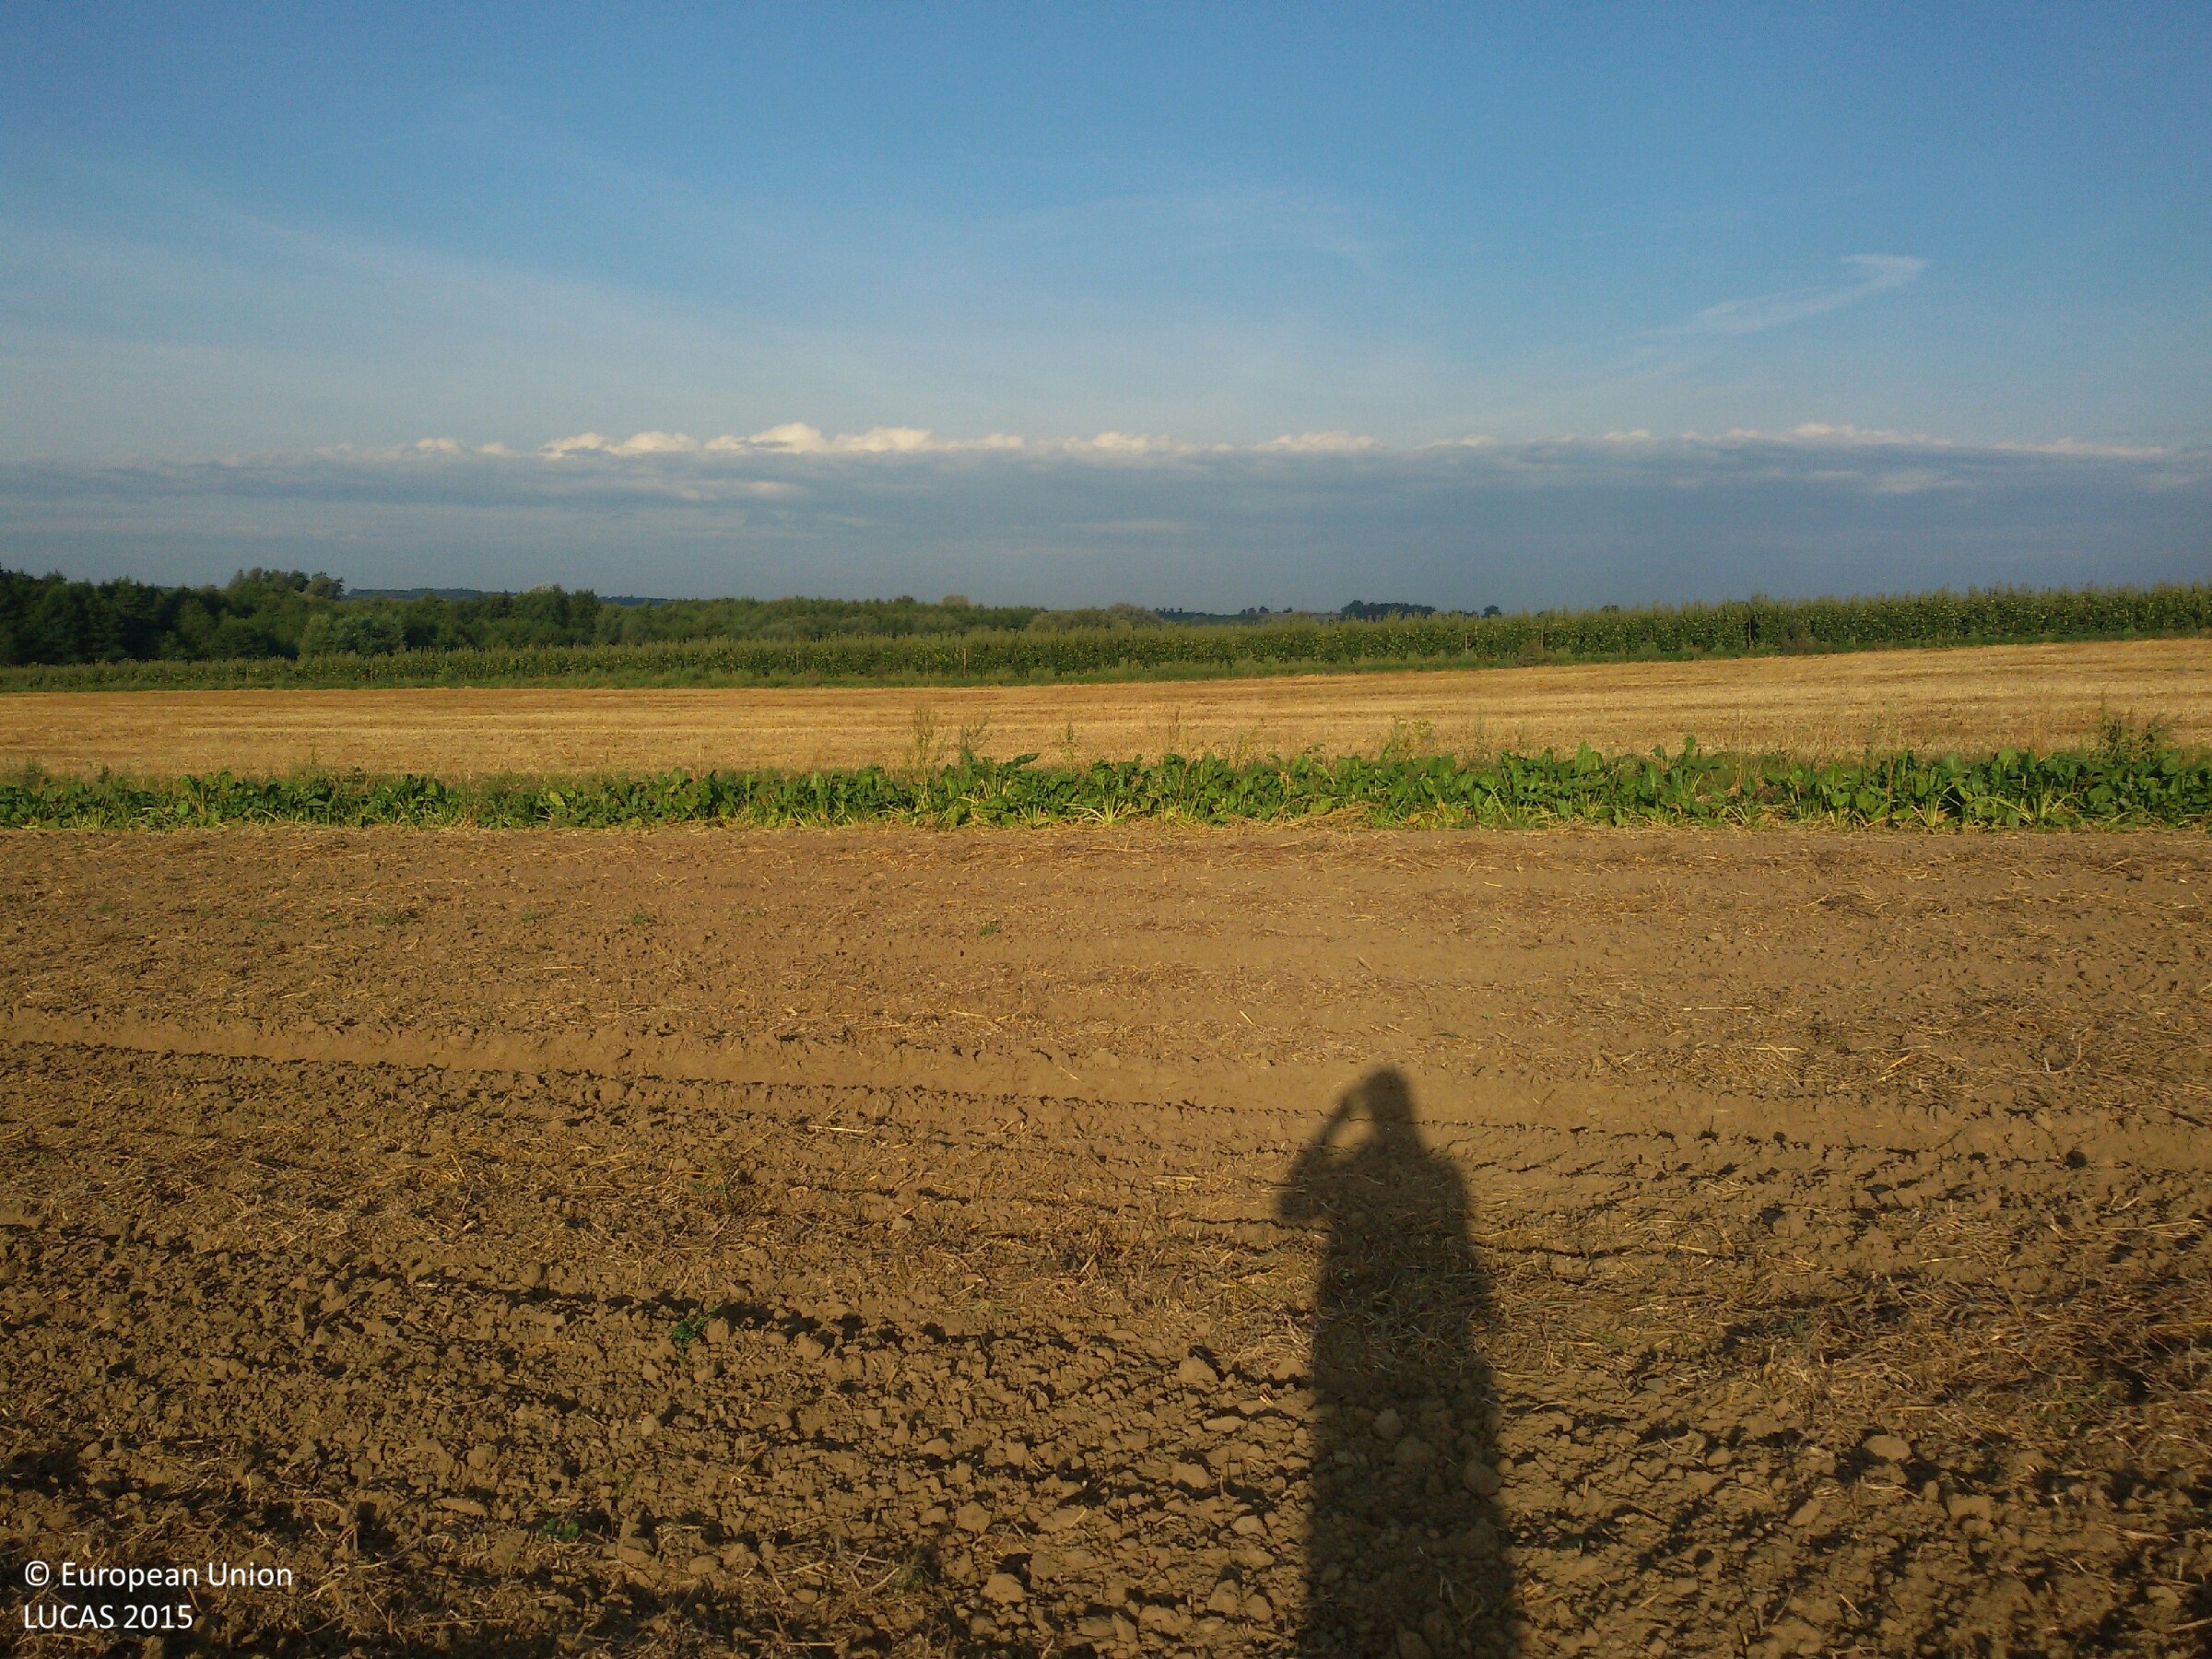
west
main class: Cropland
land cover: Other leguminous and mixtures for fodder
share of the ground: 10 - 25 %
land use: Agriculture (excluding fallow land and kitchen gardens)
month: August
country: PL
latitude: 50.7437
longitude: 21.6884
